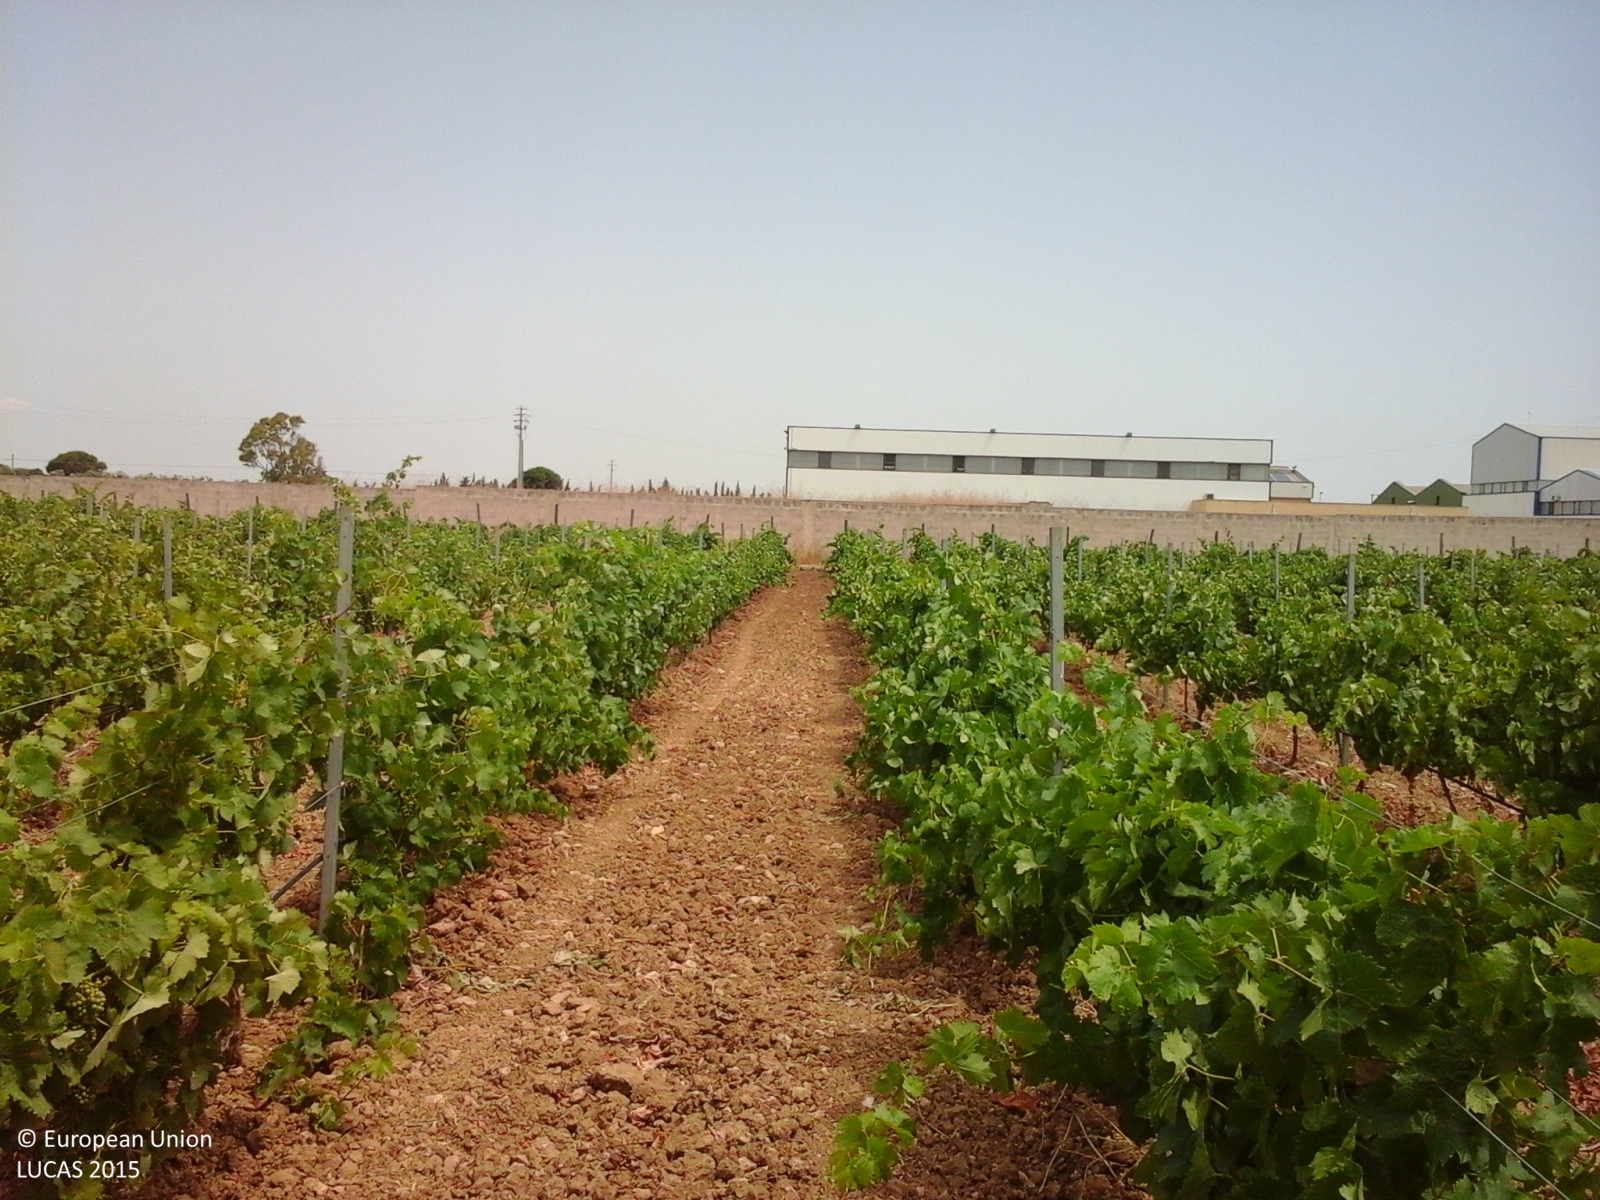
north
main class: Cropland
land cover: Vineyards
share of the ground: 10 - 25 %
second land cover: Other bare soil
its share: > 75 %
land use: Agriculture (excluding fallow land and kitchen gardens)
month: May
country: IT
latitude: 37.6369
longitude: 12.6879
